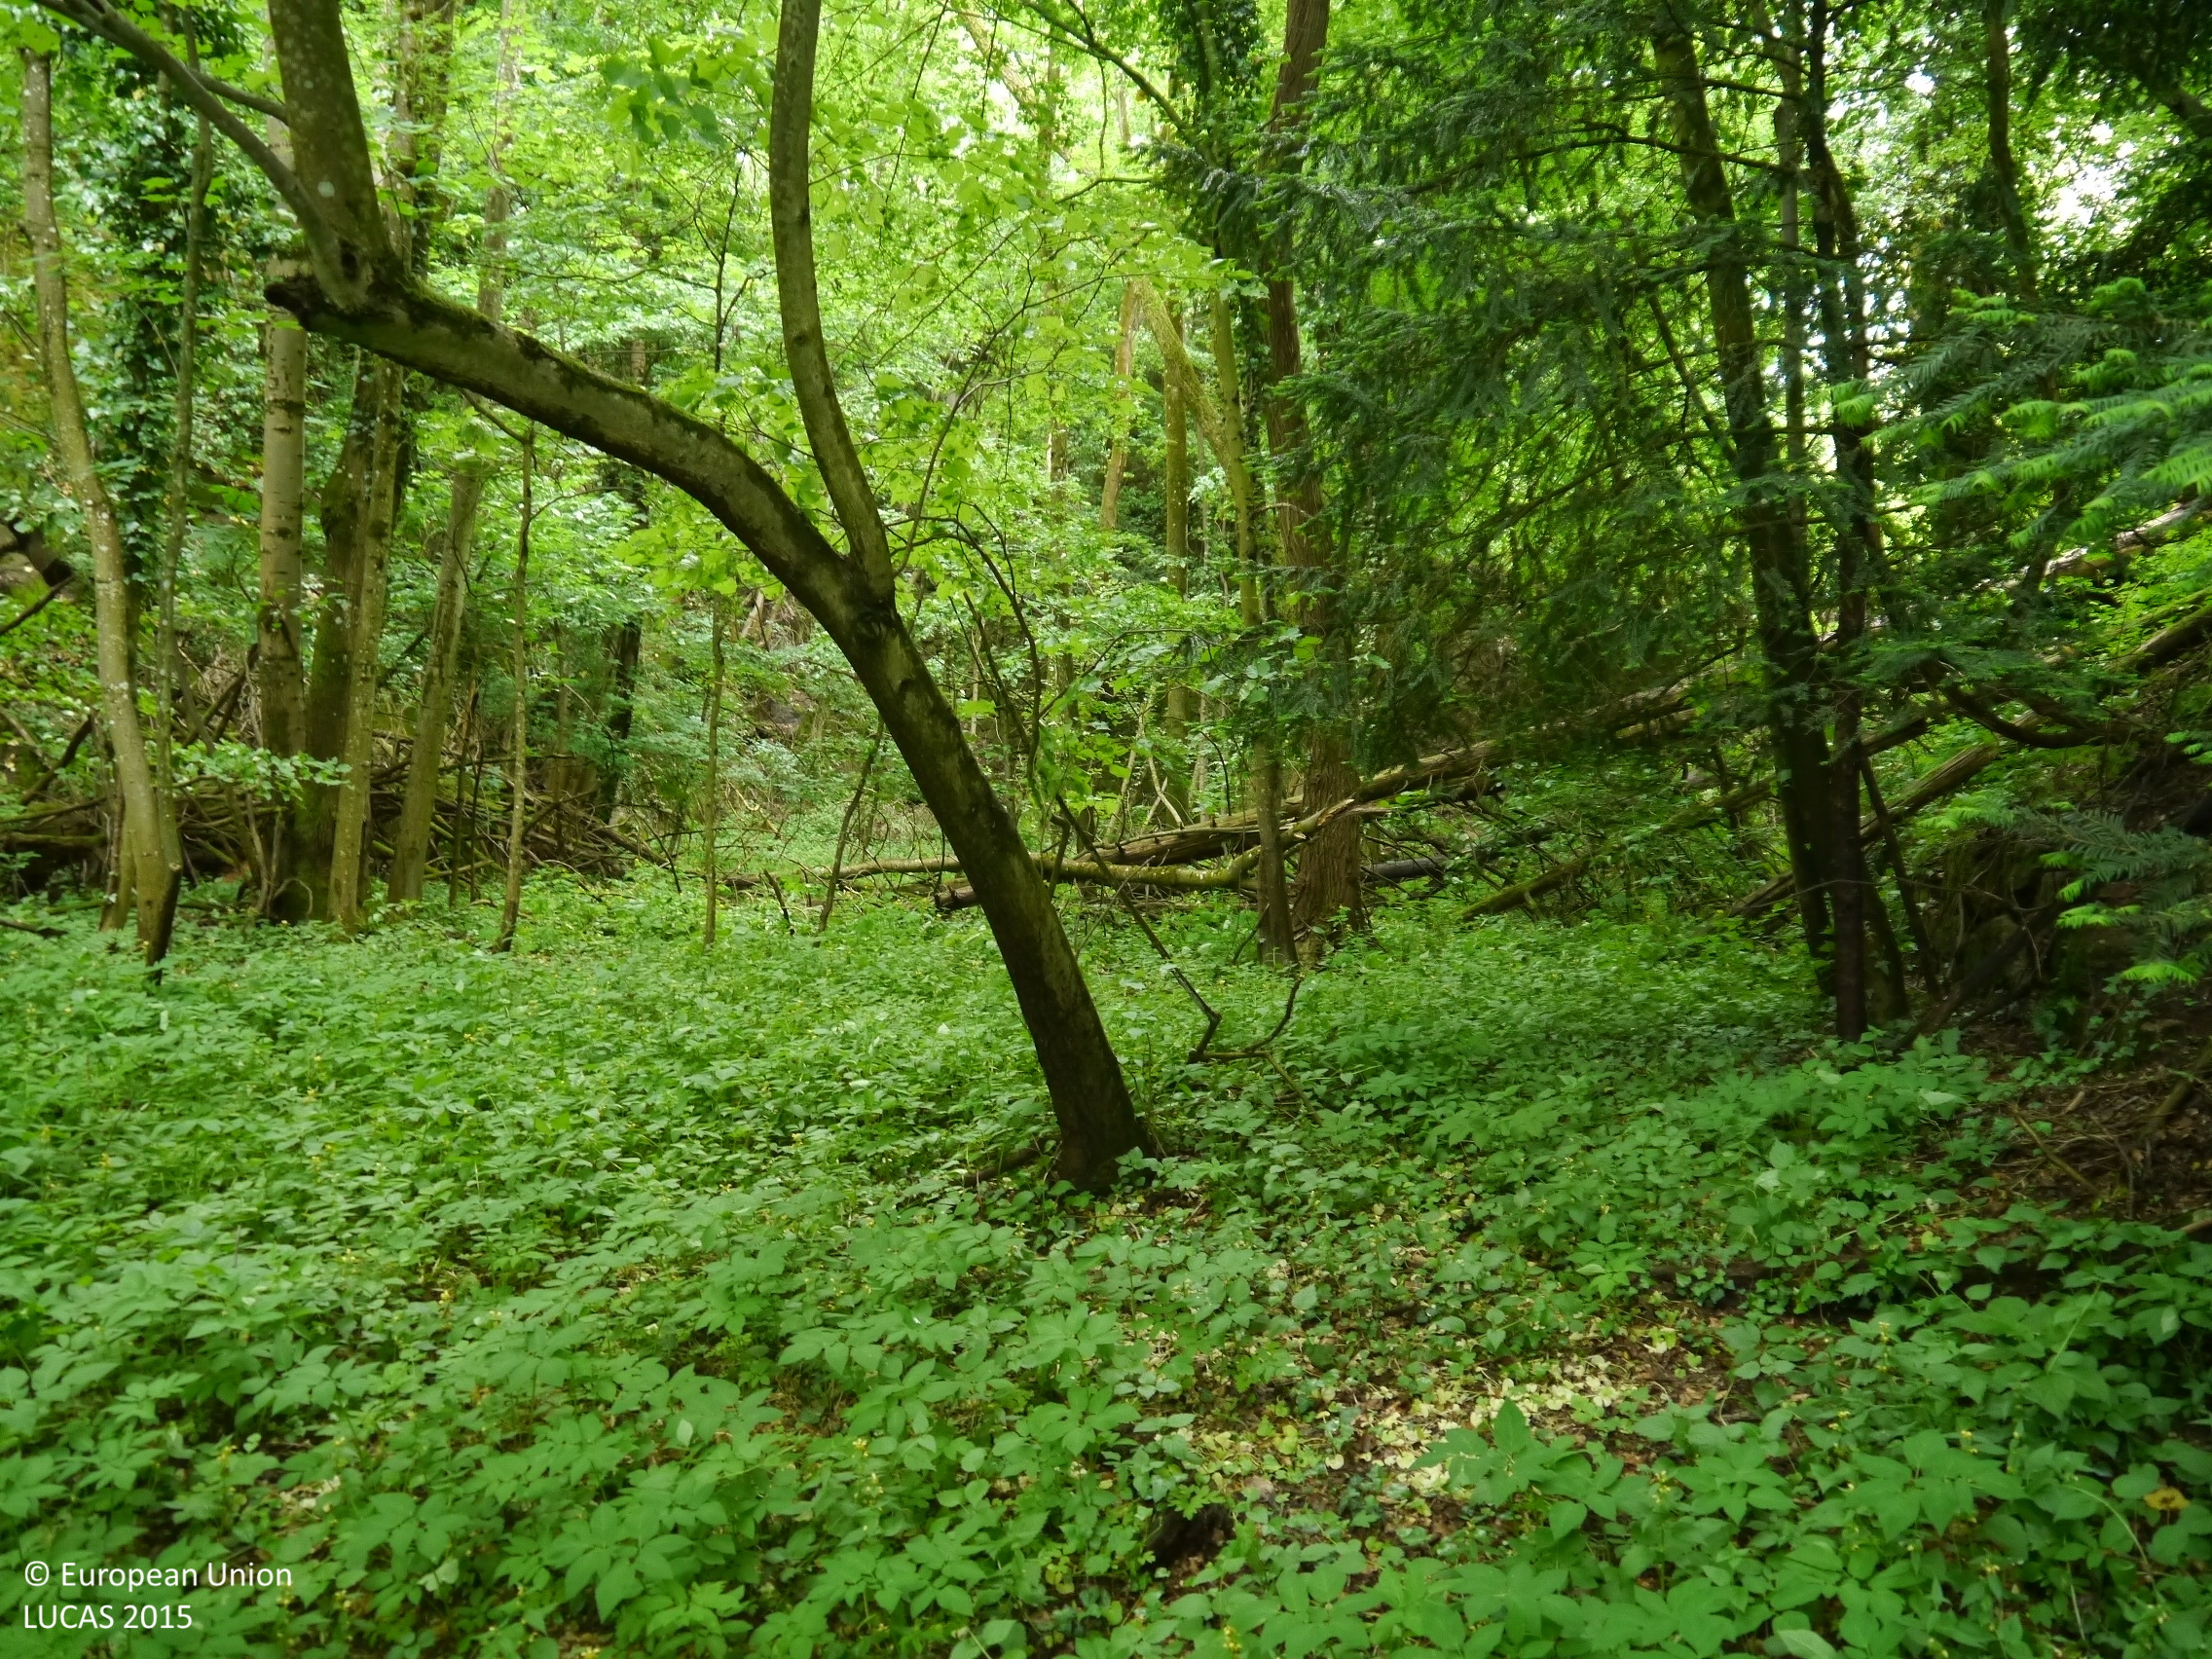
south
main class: Woodland
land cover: Broadleaved woodland
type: hemiboreal forest and nemoral coniferous forest and mixed broadleaved-coniferous forest
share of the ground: > 75 %
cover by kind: broadleaved forest trees 90 %, herbaceous plants 10 %
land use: Forestry
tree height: > 5 m
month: May
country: AT
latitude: 46.8928
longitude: 15.8936
